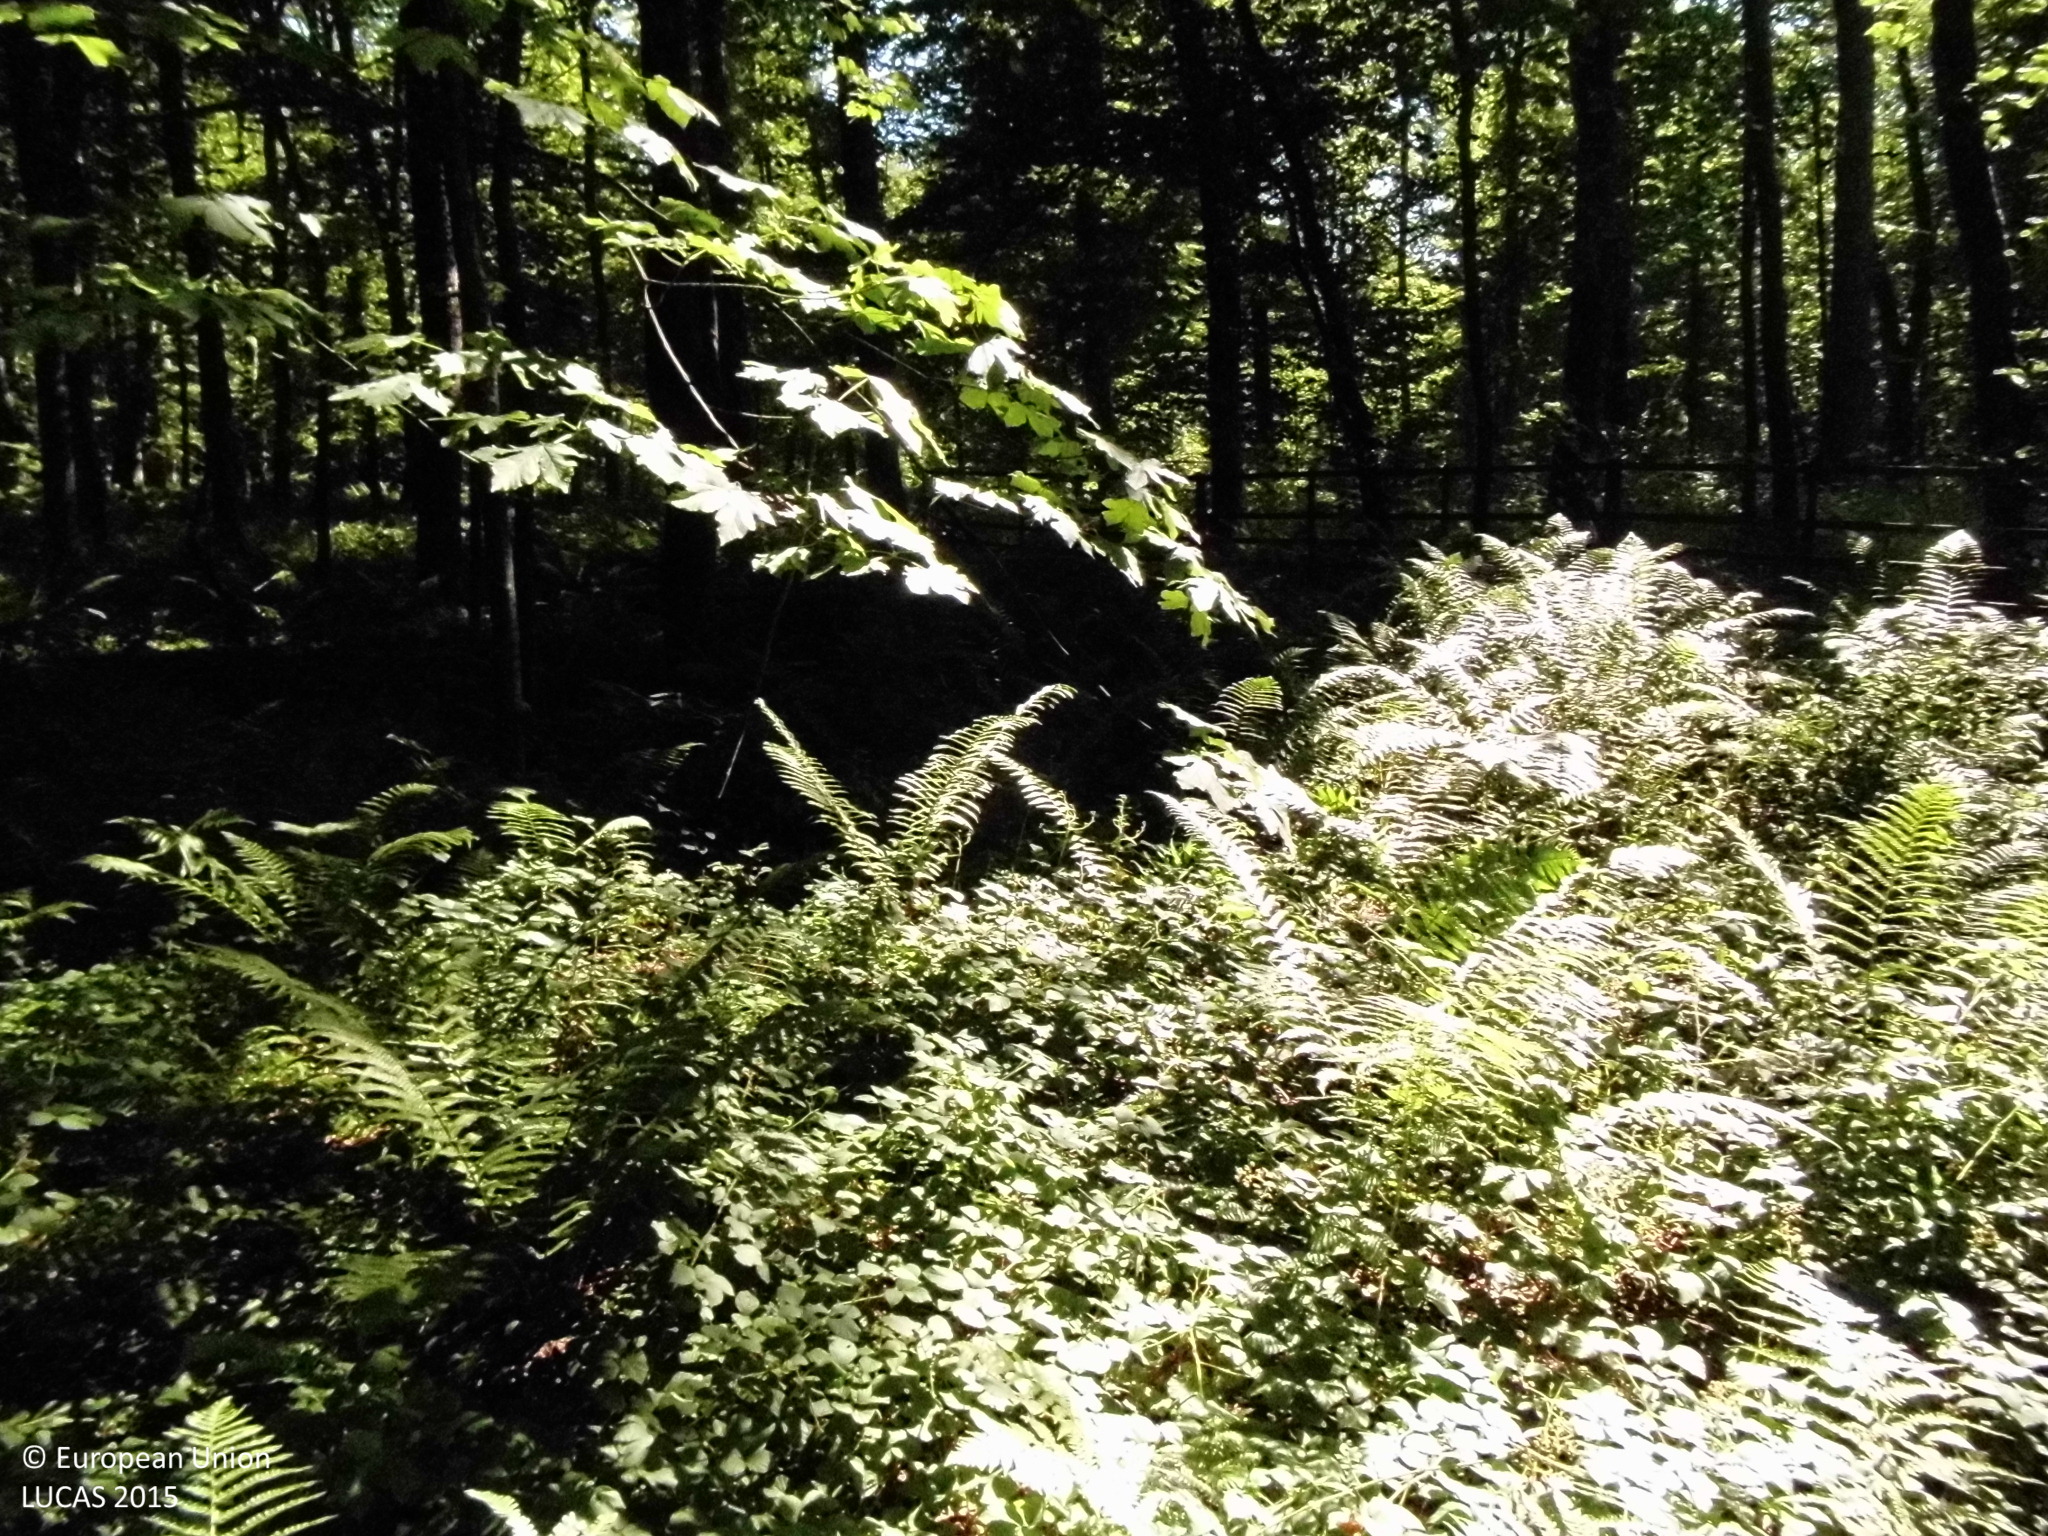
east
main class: Woodland
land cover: Broadleaved woodland
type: mesophytic deciduous forest
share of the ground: > 75 %
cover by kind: broadleaved forest trees 80 %, herbaceous plants 20 %
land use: Forestry
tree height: > 5 m
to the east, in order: Broadleaved woodland; Fences; Broadleaved woodland; Fences; Broadleaved woodland; Grass margins; Tracks; Grass margins; Ditches and canals; Broadleaved woodland; Tracks; Grass margins; Tracks; Ditches and canals; Broadleaved woodland
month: August
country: DE
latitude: 50.6539
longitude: 8.0909
